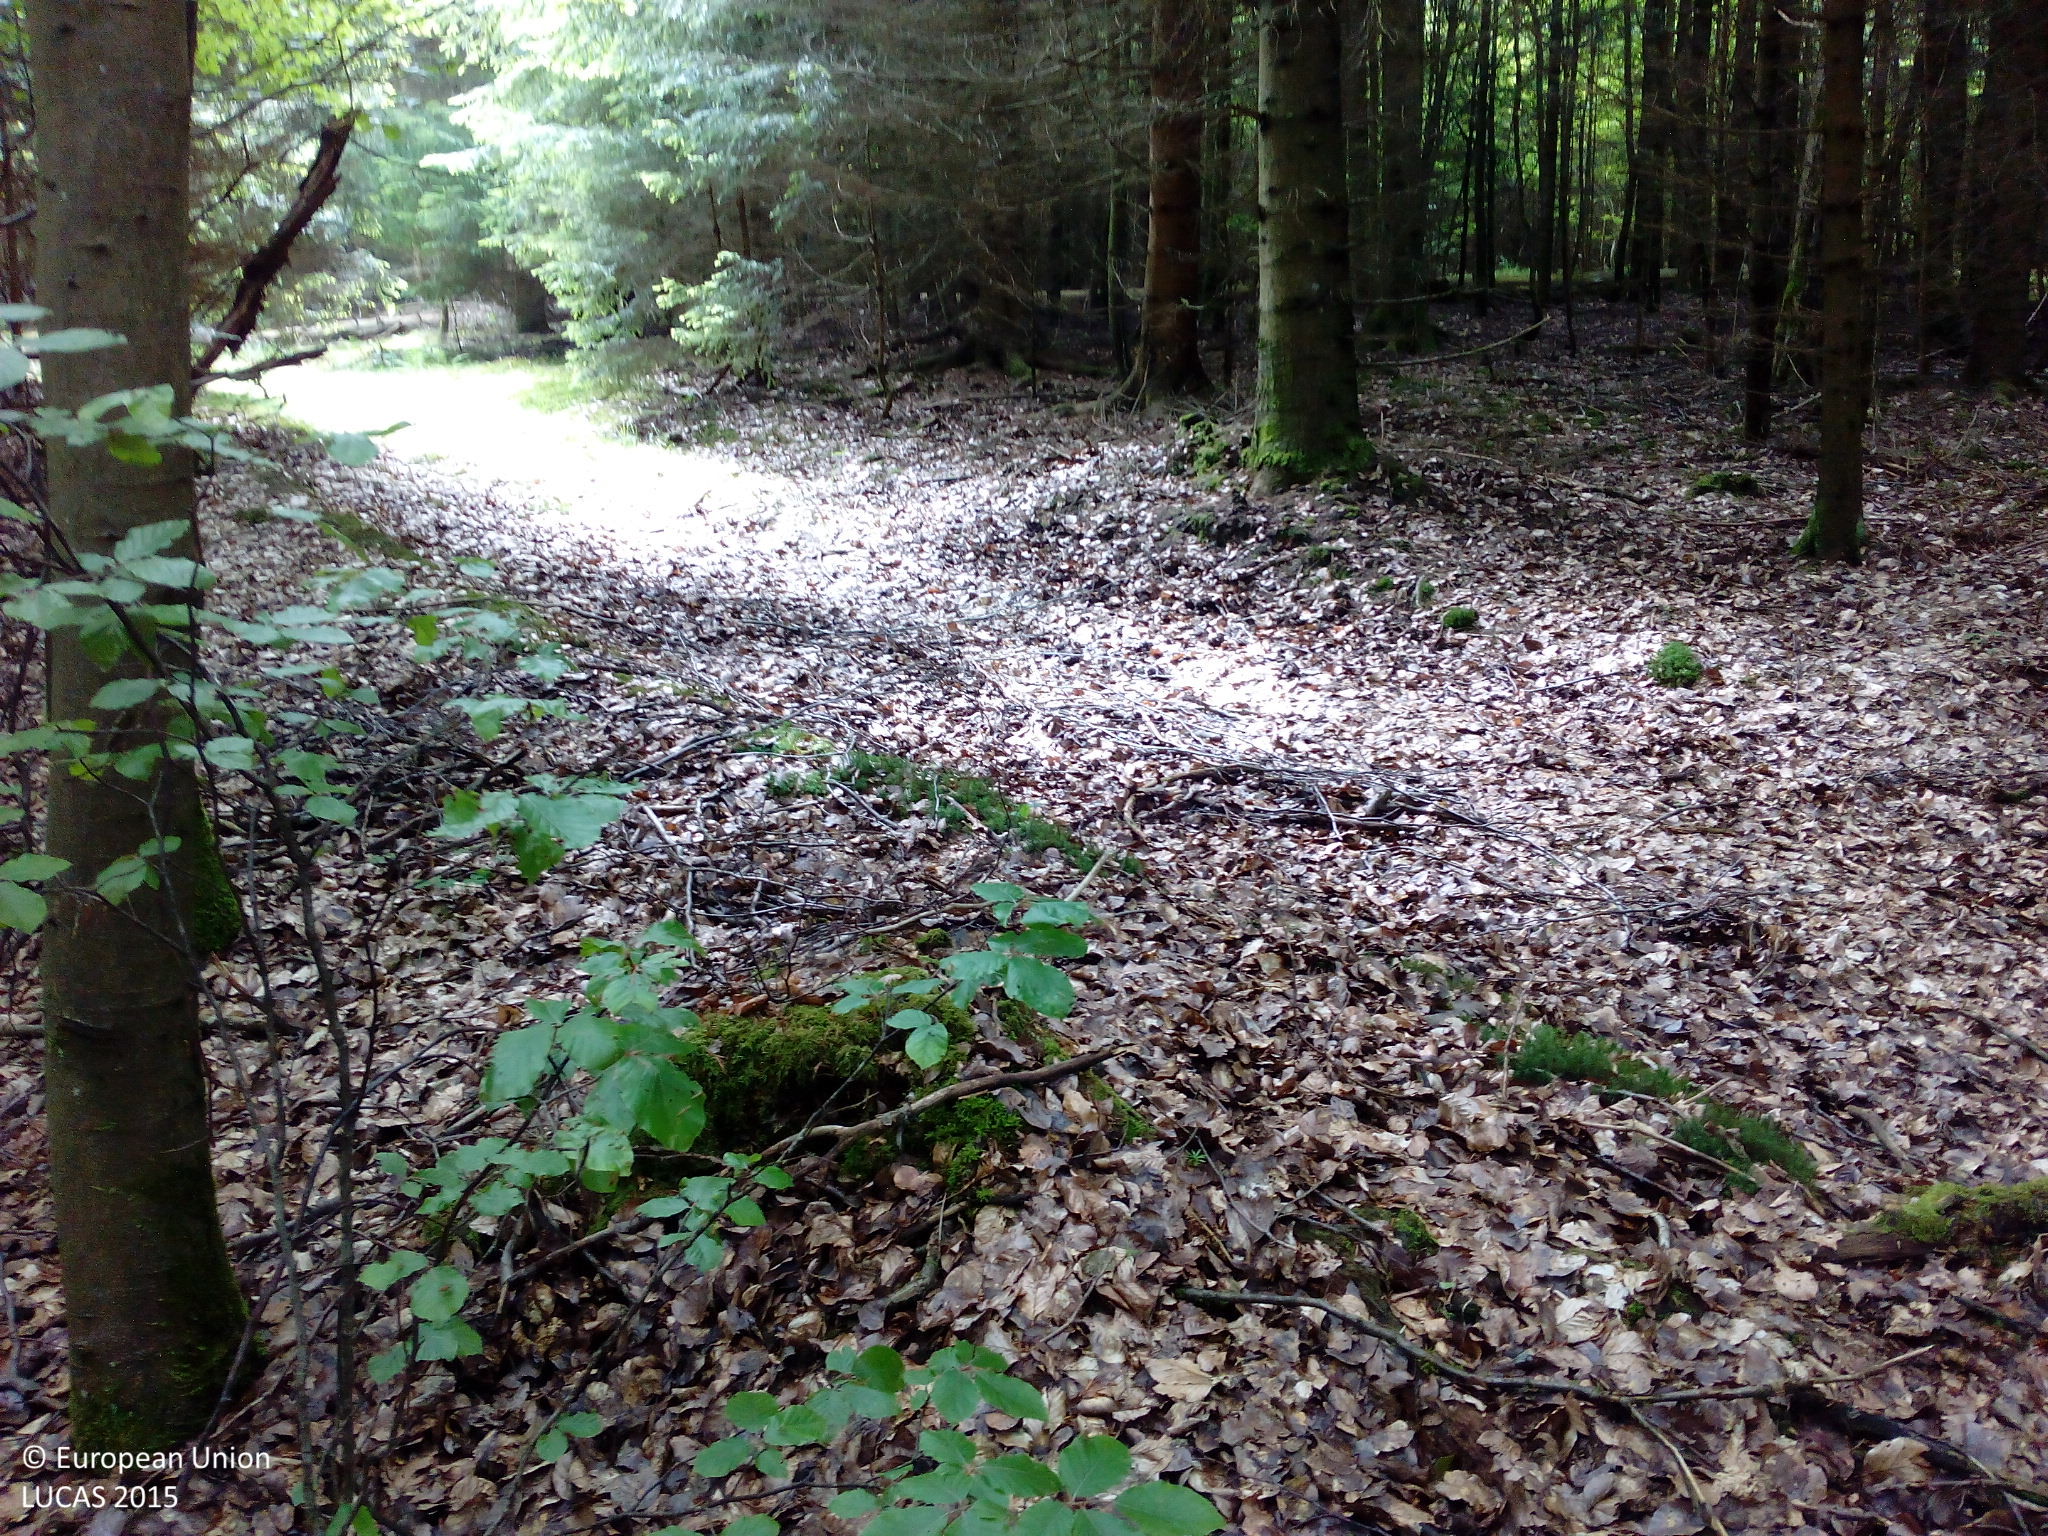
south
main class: Woodland
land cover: Spruce dominated mixed woodland
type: hemiboreal forest and nemoral coniferous forest and mixed broadleaved-coniferous forest
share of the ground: > 75 %
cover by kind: broadleaved forest trees 50 %, coniferous forest trees 30 %, unconsolidated bare surface 15 %, lichens and mosses 5 %
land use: Forestry
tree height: > 5 m
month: June
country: DE
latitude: 48.9626
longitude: 11.9252
